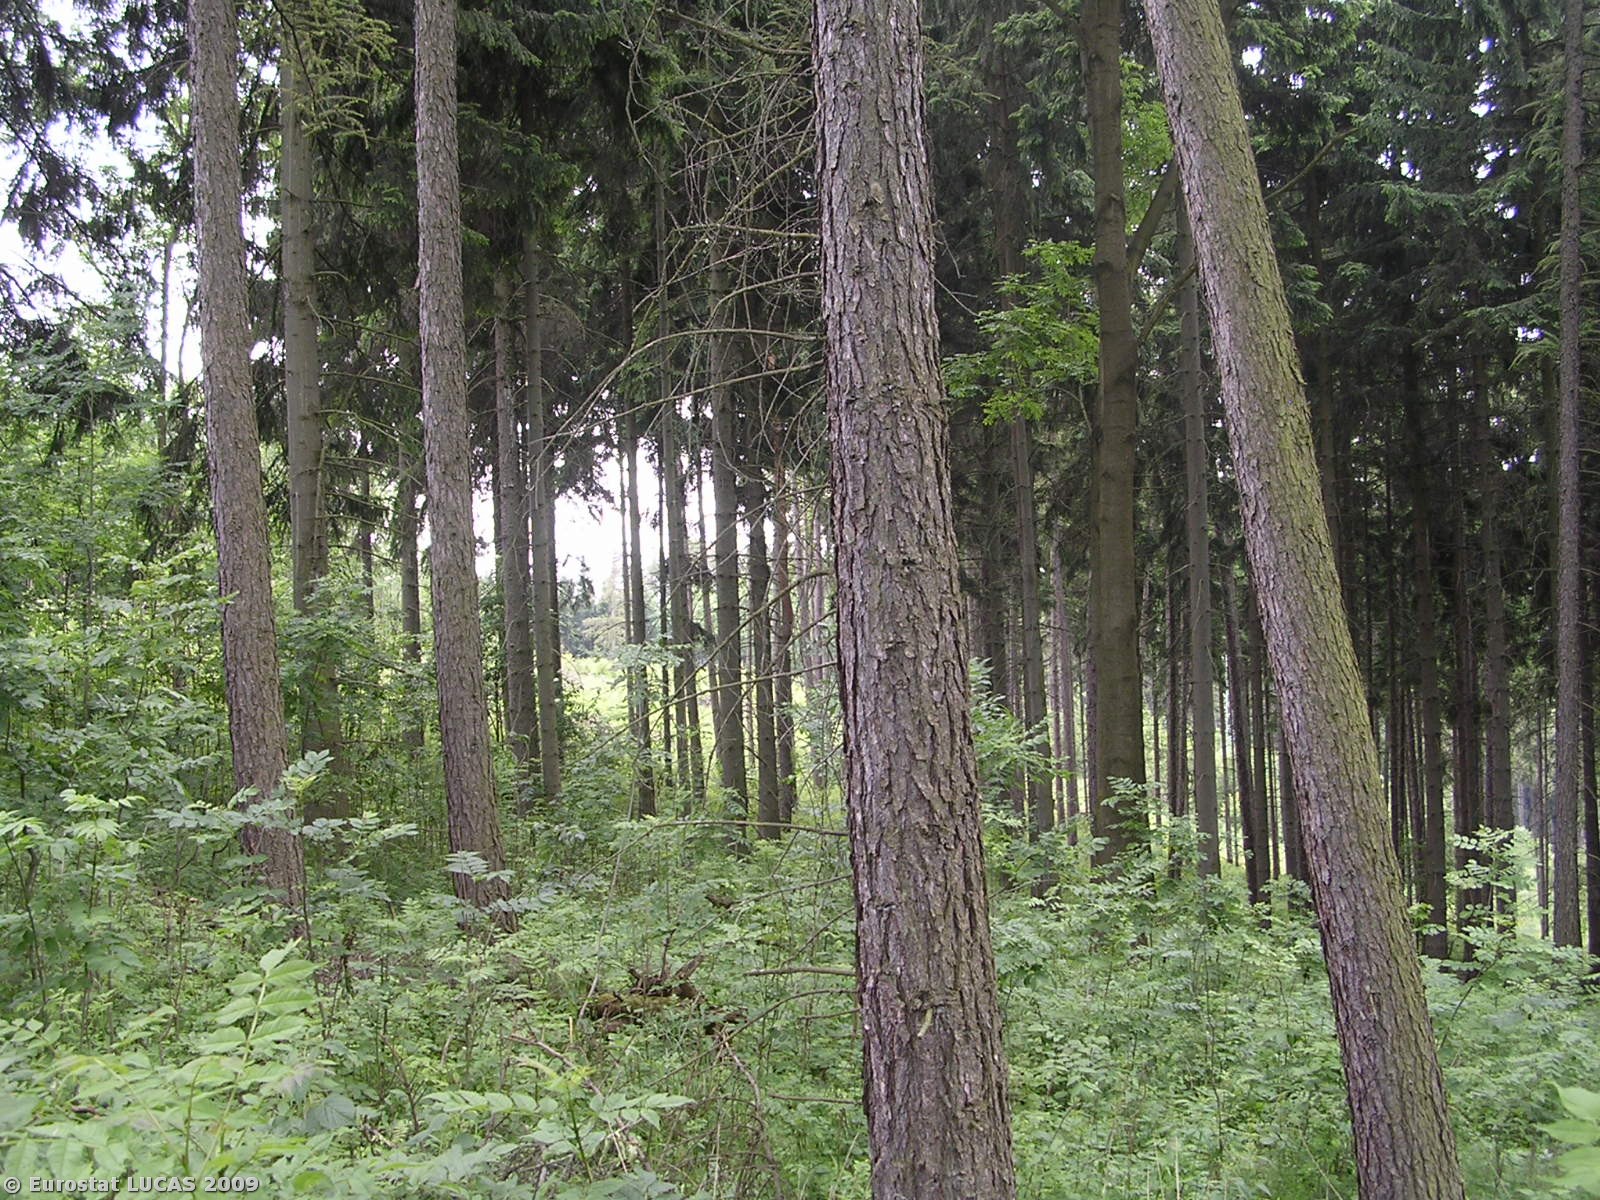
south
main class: Woodland
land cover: Mixed woodland
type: hemiboreal forest and nemoral coniferous forest and mixed broadleaved-coniferous forest
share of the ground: > 75 %
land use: Forestry
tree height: > 5 m
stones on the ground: < 10 %
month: June
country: CZ
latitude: 50.6291
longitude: 14.2000
